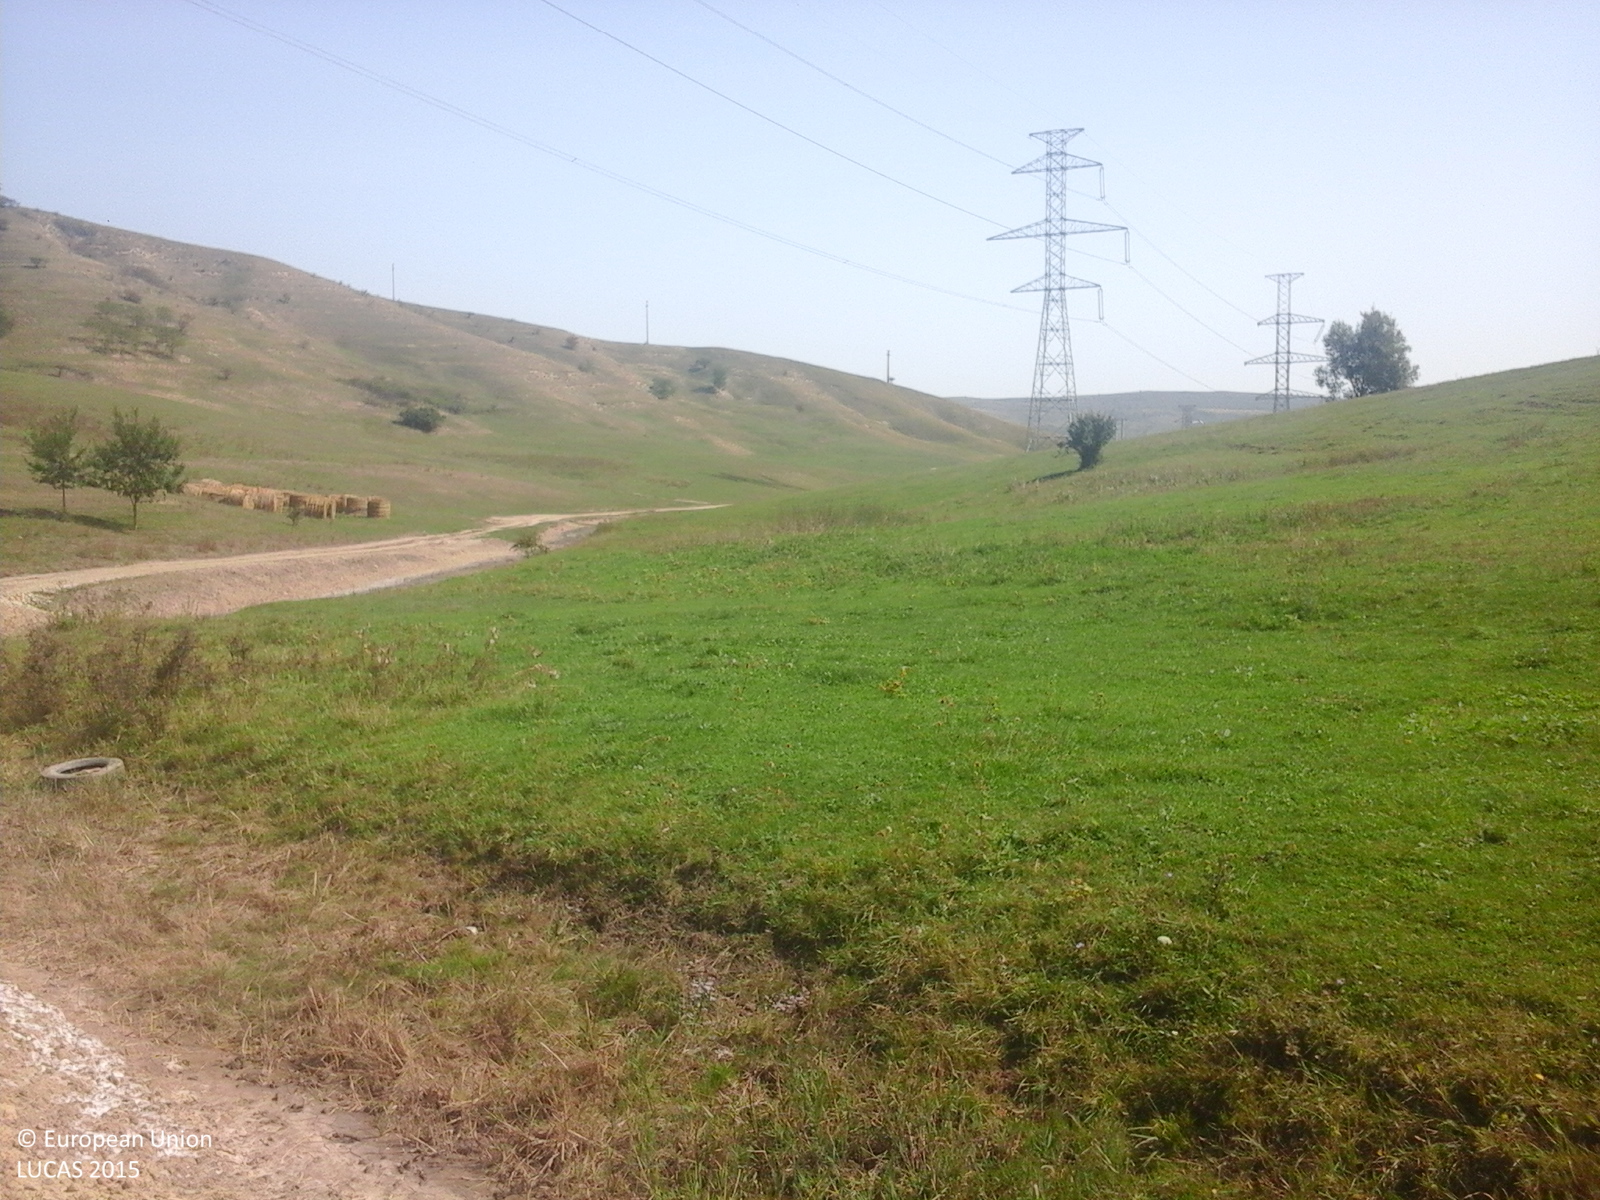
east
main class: Grassland
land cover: Grassland without tree/shrub cover
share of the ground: > 75 %
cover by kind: herbaceous plants 100 %
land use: Agriculture (excluding fallow land and kitchen gardens)
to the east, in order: Grassland without tree/shrub cover; Ditches and canals; Grassland without tree/shrub cover; Electric lines; Grassland without tree/shrub cover; Ditches and canals; Grass margins; Tracks; Grassland without tree/shrub cover
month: September
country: RO
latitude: 46.8355
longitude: 23.8293
